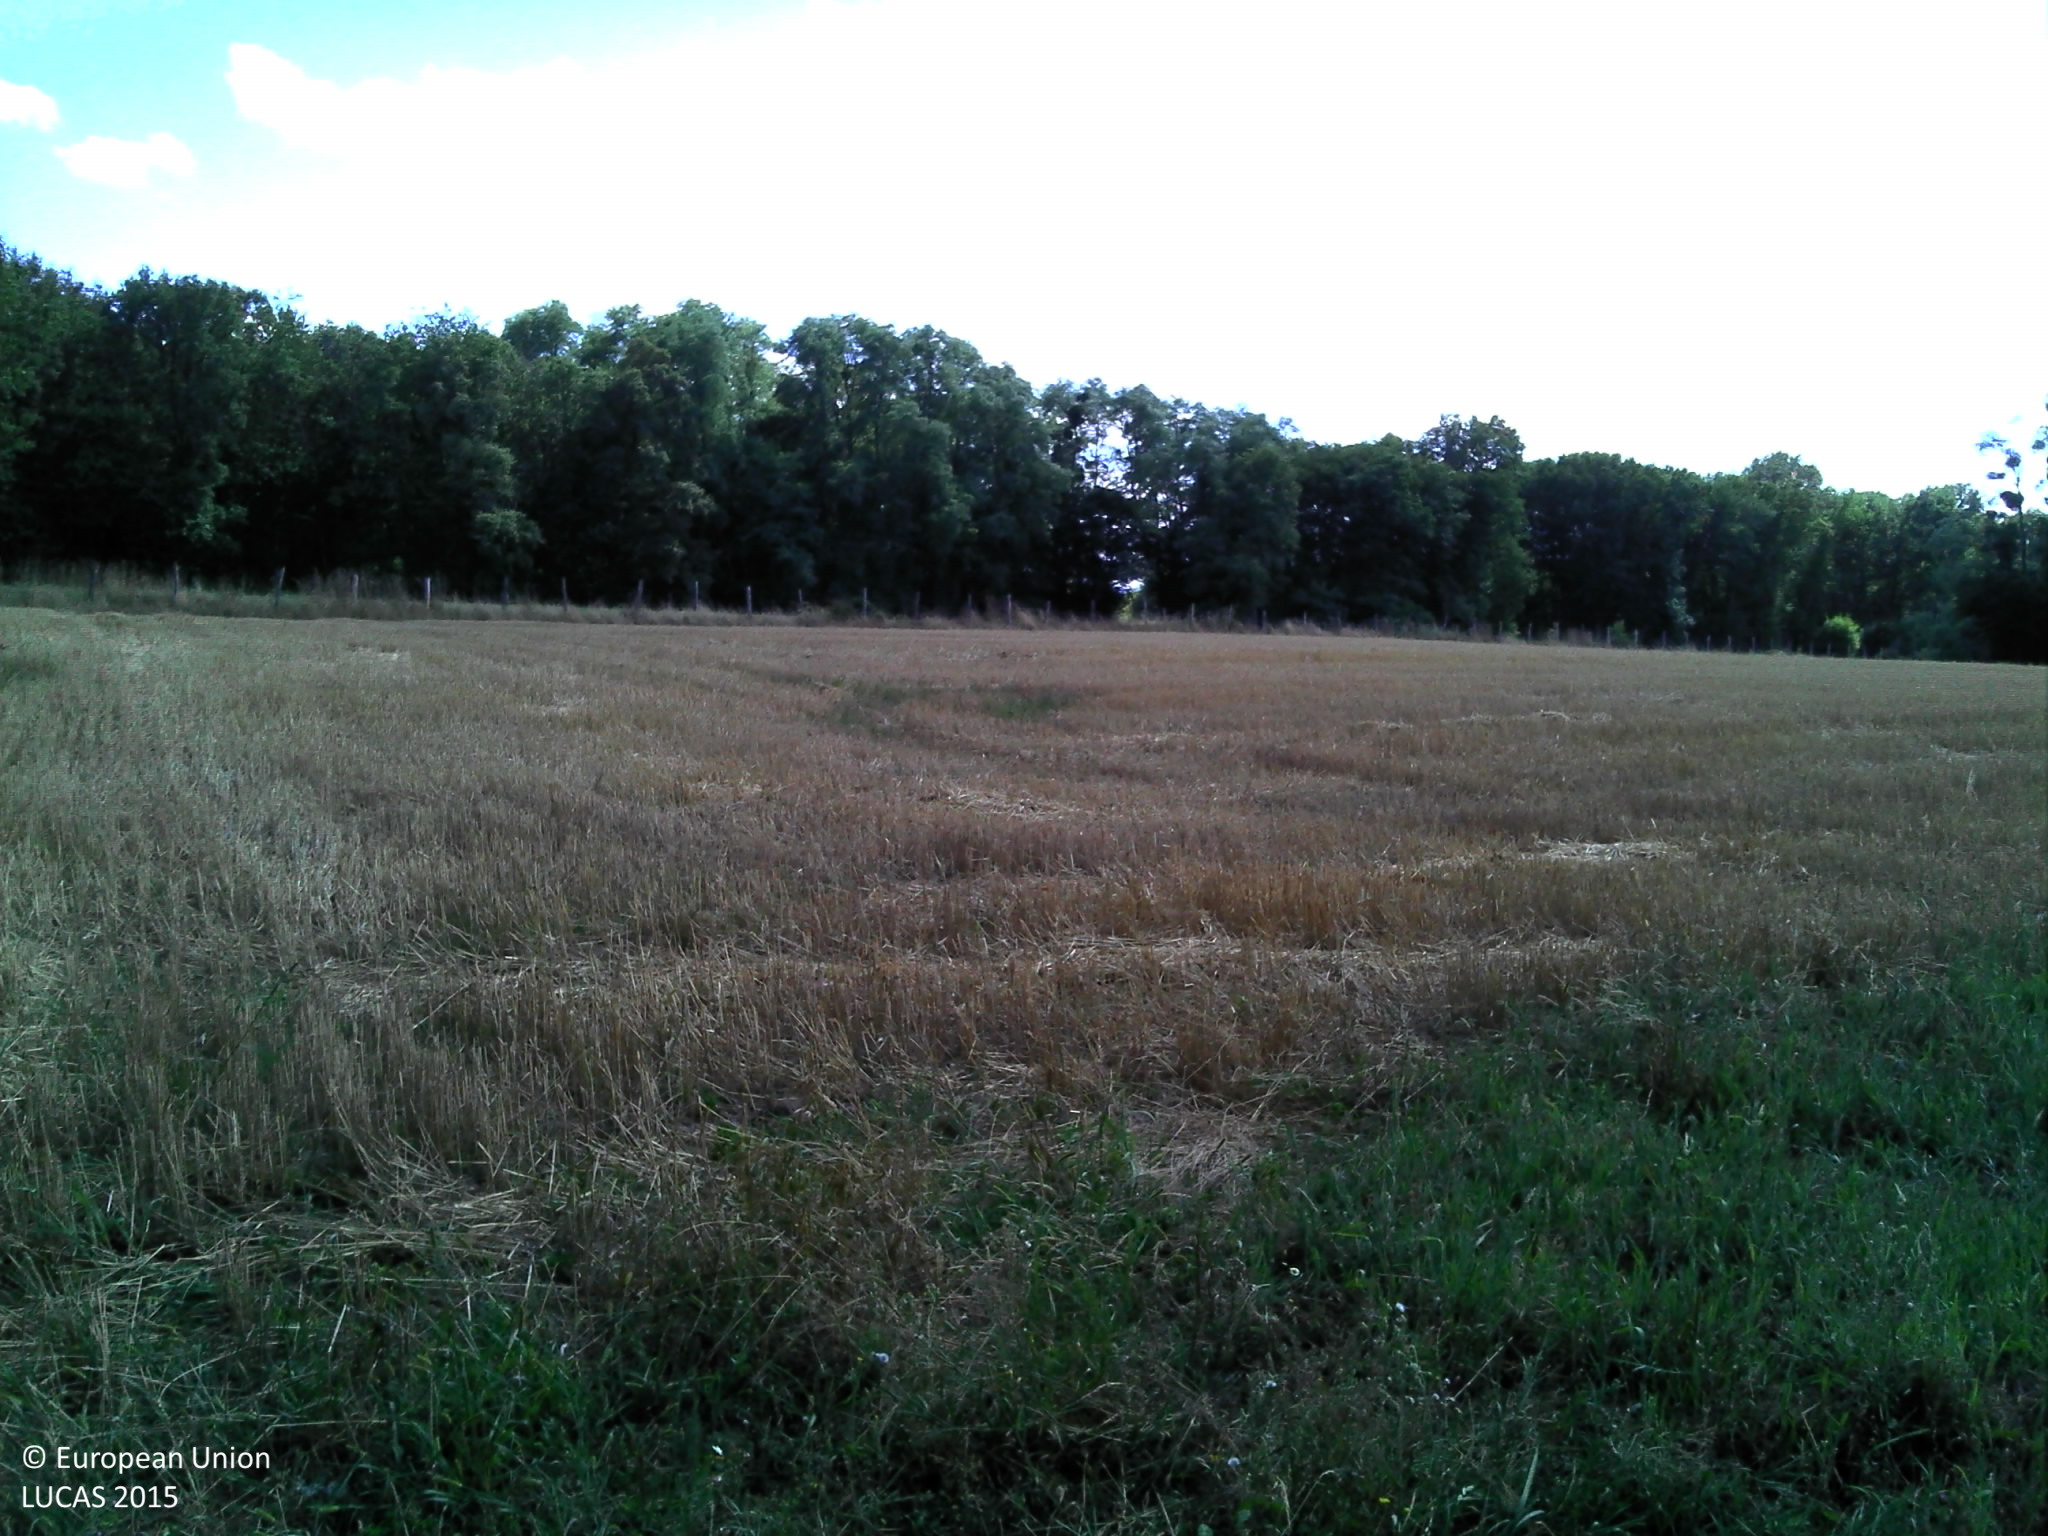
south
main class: Grassland
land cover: Spontaneously vegetated surfaces
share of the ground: > 75 %
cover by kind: herbaceous plants 100 %
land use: Fallow land
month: July
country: FR
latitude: 47.5785
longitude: 3.1744
